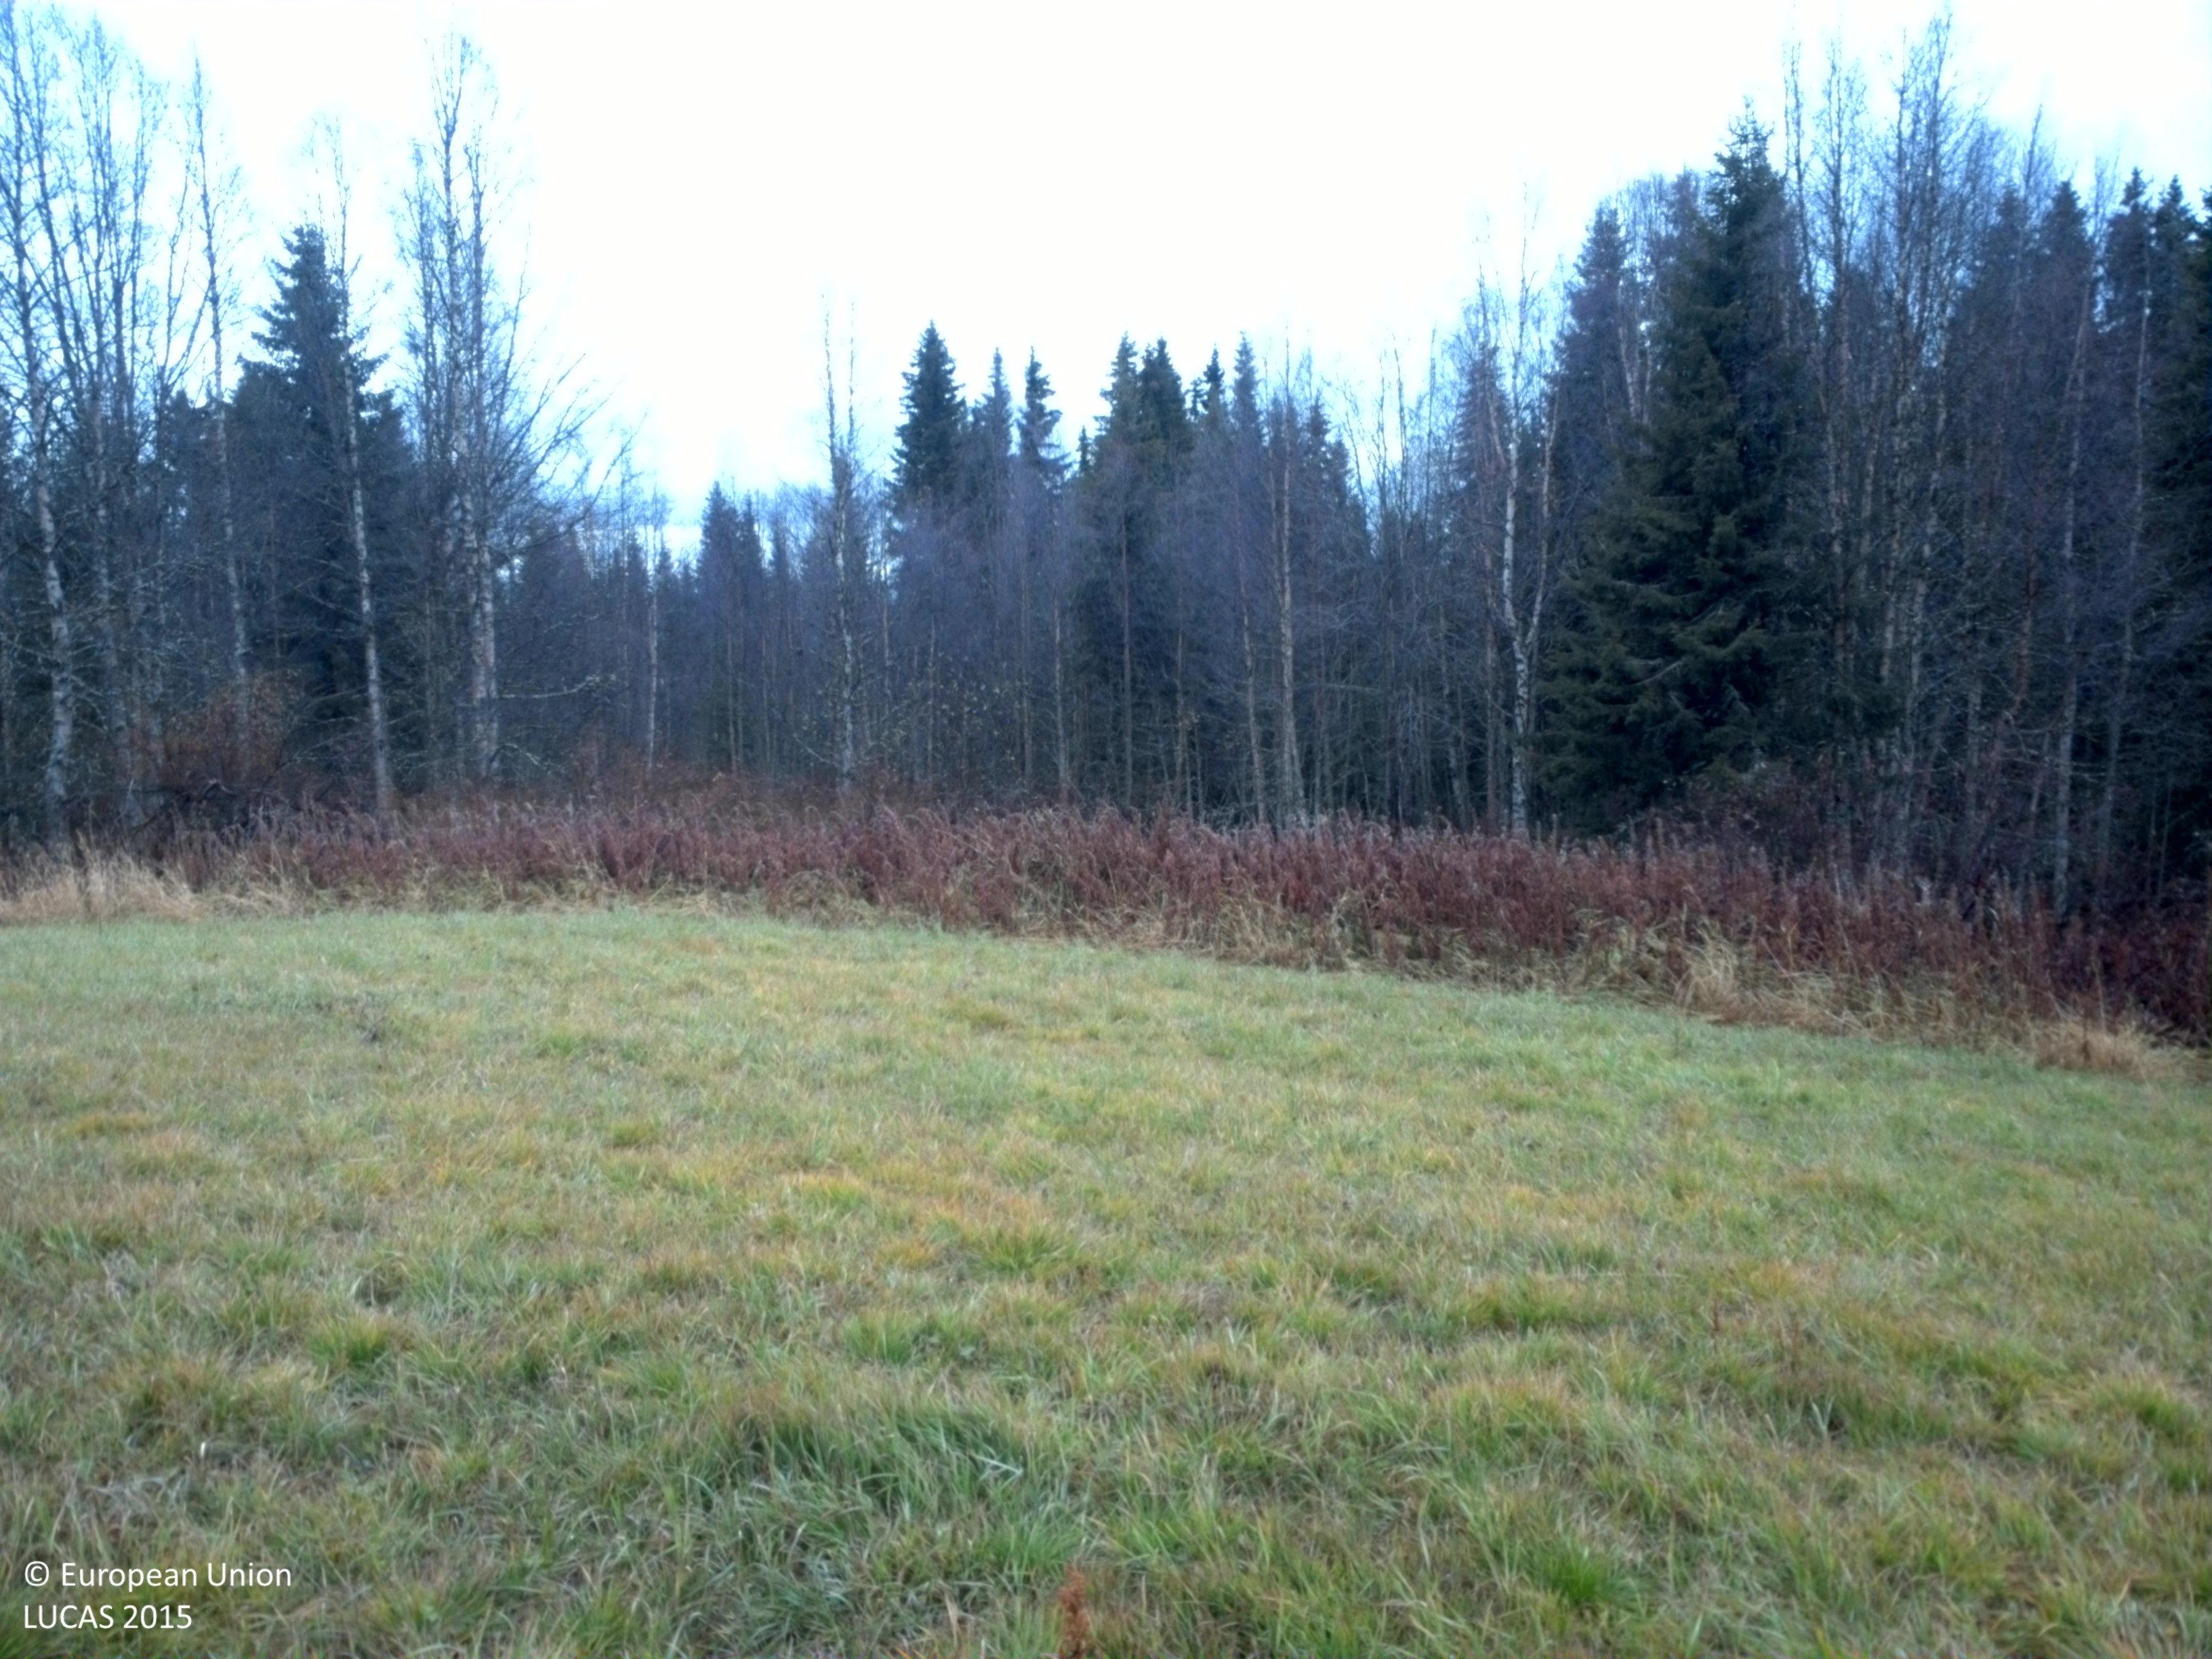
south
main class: Cropland
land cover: Temporary grasslands
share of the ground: > 75 %
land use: Agriculture (excluding fallow land and kitchen gardens)
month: October
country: SE
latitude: 64.5535
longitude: 17.3718
